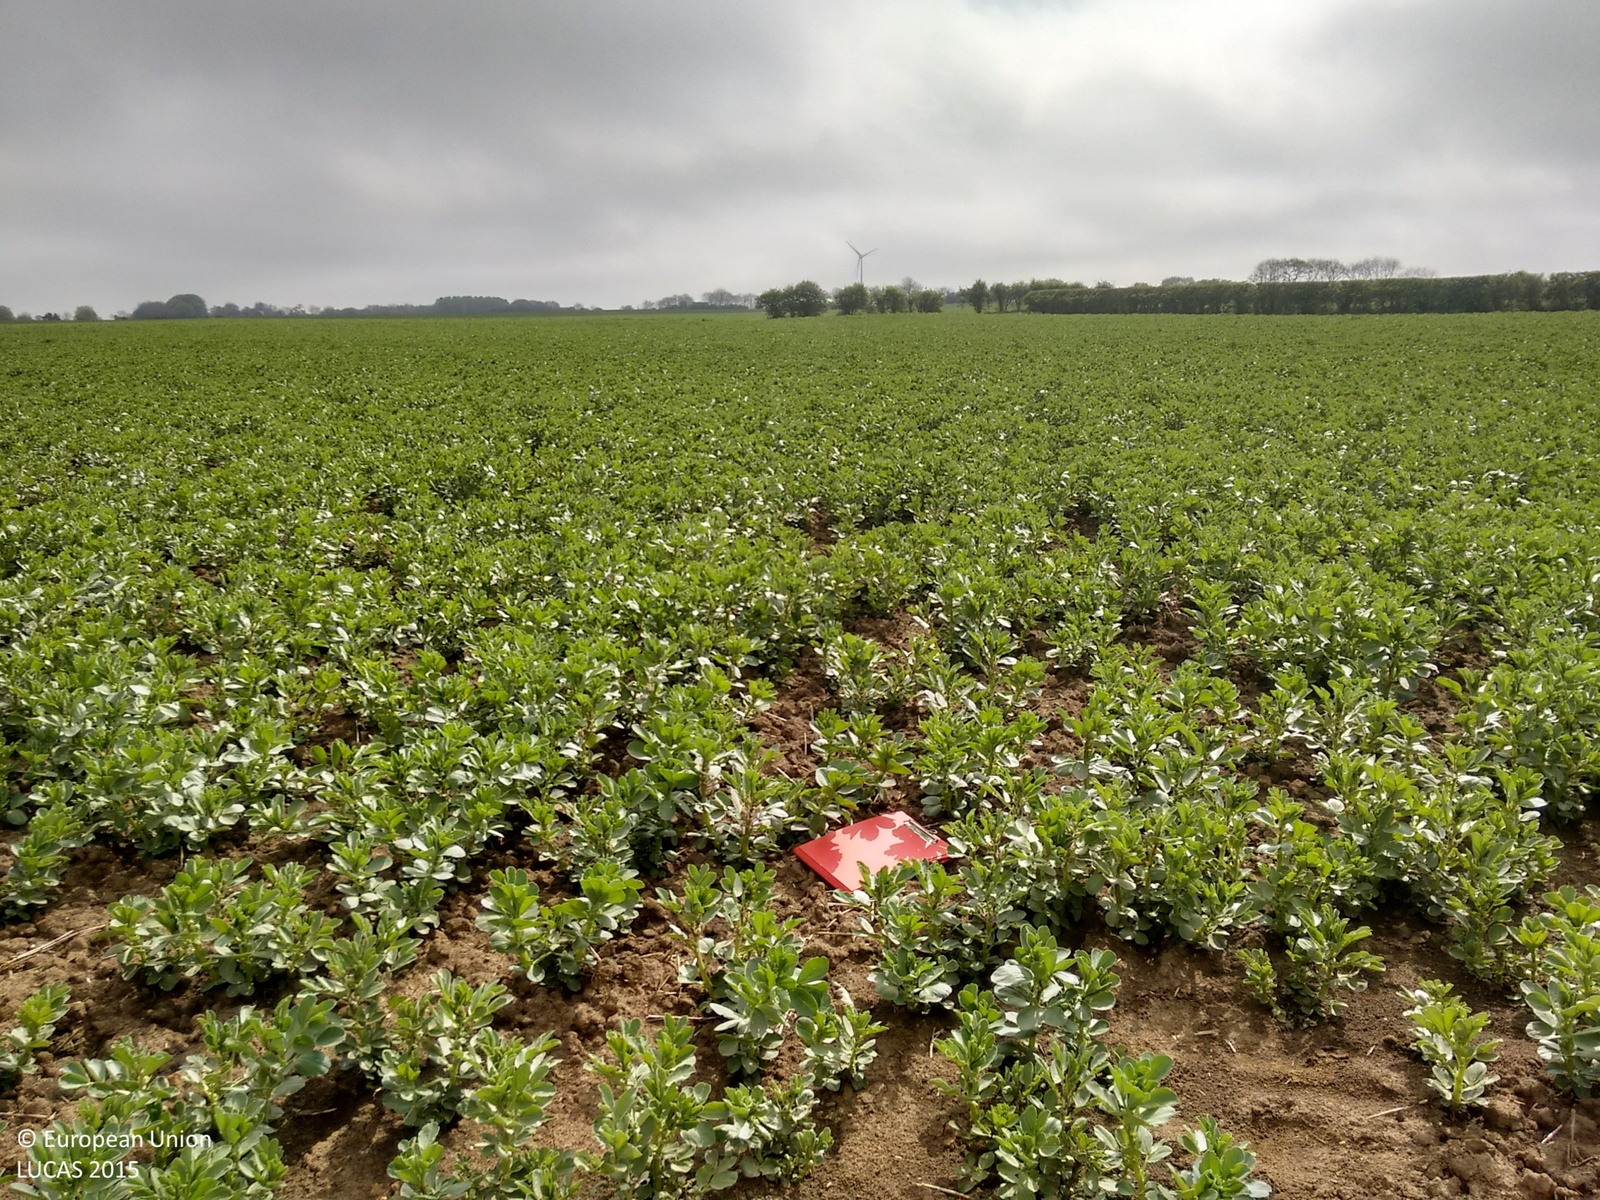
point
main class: Cropland
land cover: Dry pulses
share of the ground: > 75 %
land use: Agriculture (excluding fallow land and kitchen gardens)
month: May
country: GB
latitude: 53.9620
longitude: -0.2611
